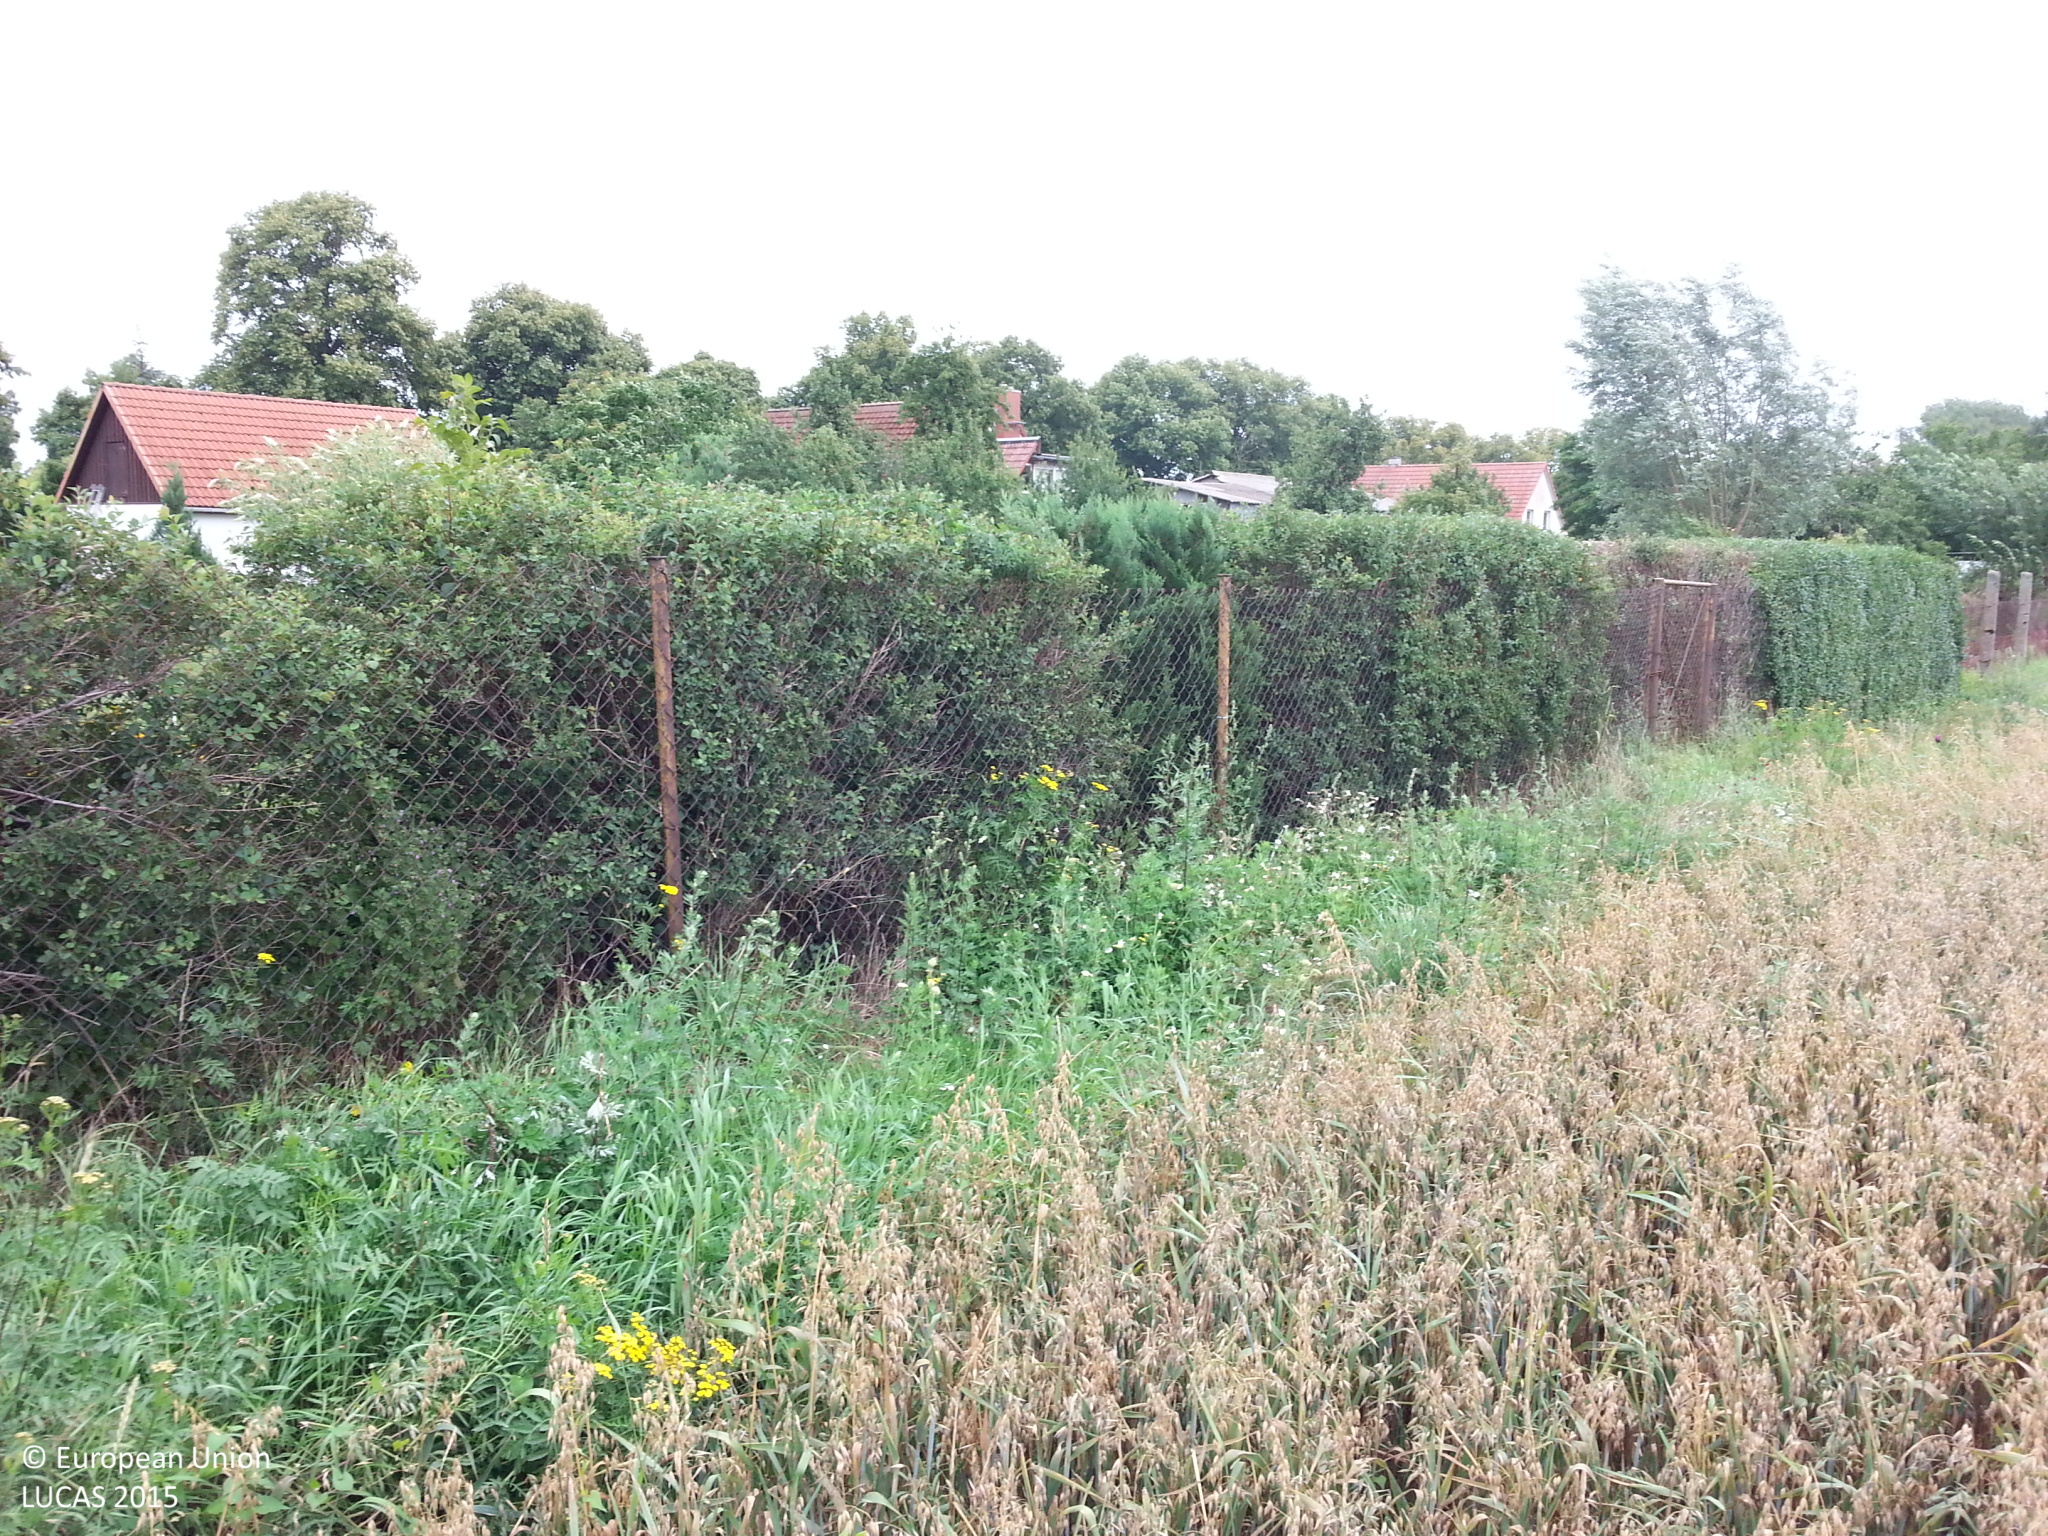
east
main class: Cropland
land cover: Barley
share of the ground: > 75 %
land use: Agriculture (excluding fallow land and kitchen gardens)
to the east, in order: Barley; Grass margins; Artificial constructions in urban areas; Lines of trees; Maize
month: July
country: DE
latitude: 53.0736
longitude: 12.3428
